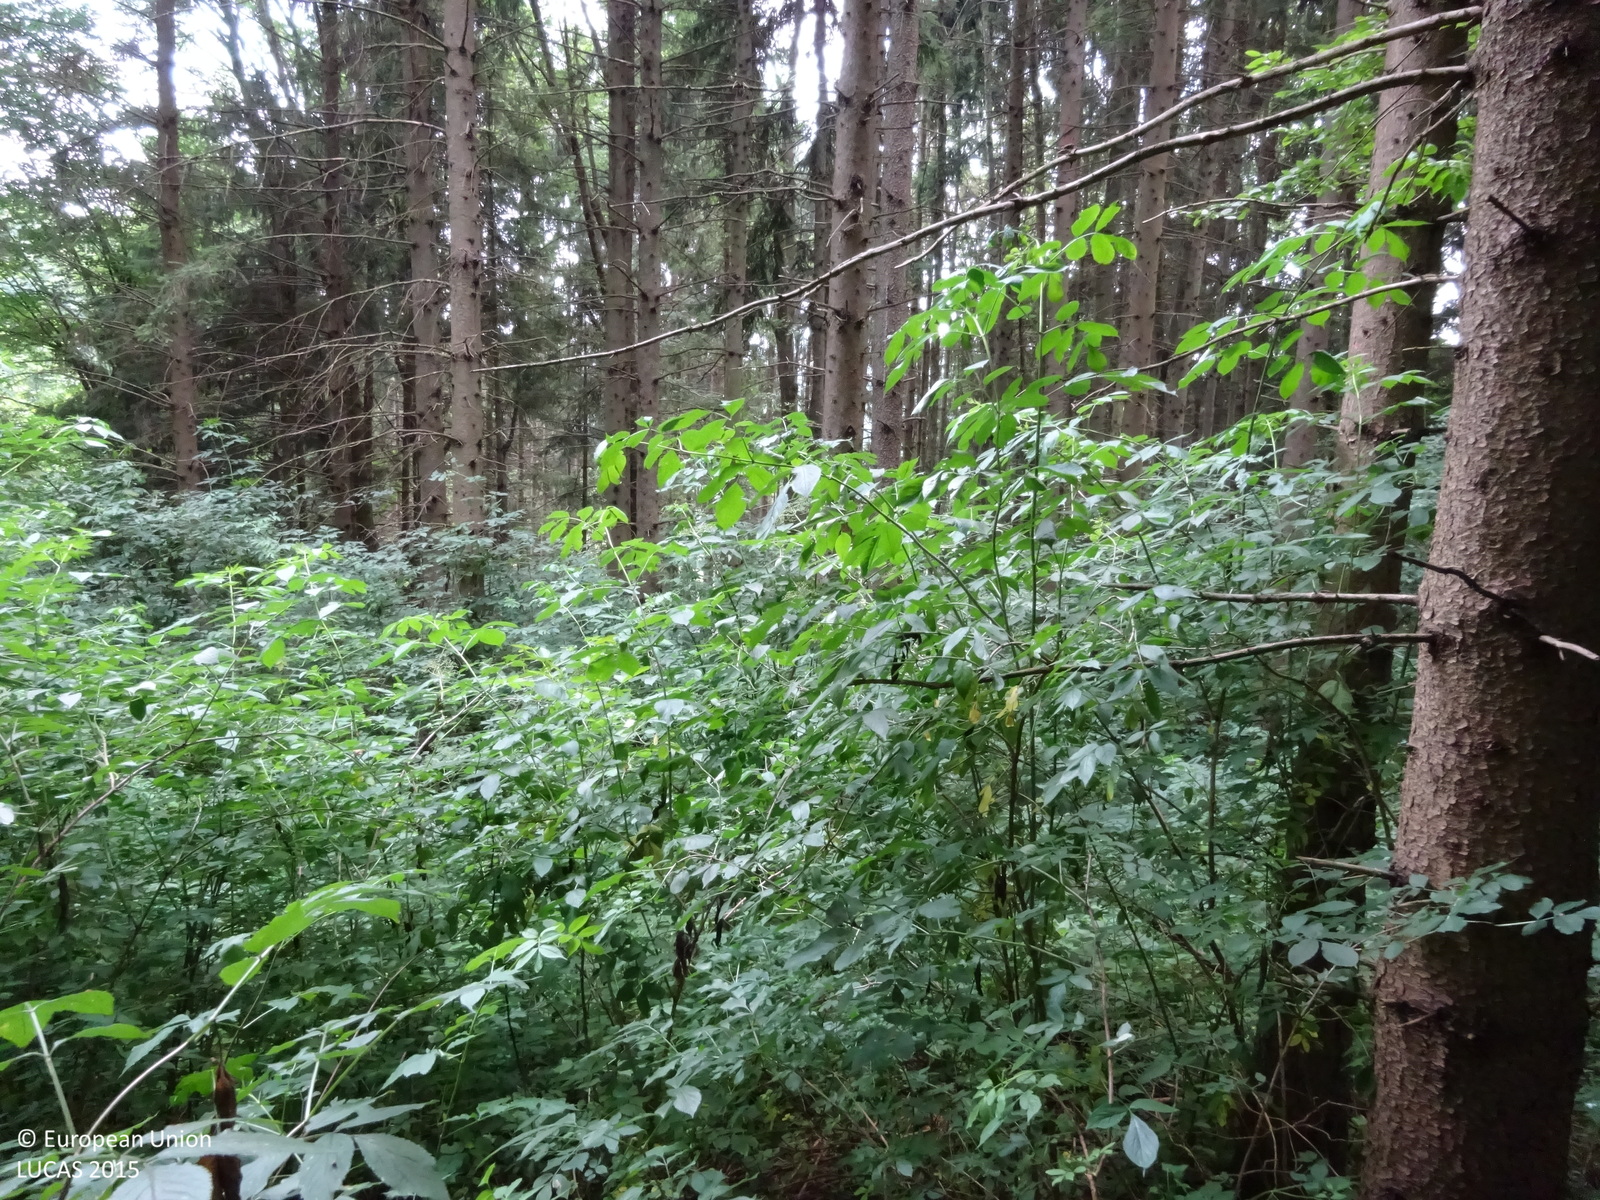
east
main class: Woodland
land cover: Spruce dominated mixed woodland
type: mountainous beech forest
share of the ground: > 75 %
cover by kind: broadleaved forest trees 65 %, coniferous forest trees 25 %, shrubs 10 %
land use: Forestry
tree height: > 5 m
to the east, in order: Spruce dominated mixed woodland; Spruce dominated coniferous woodland; Tracks; Spruce dominated coniferous woodland; Grassland without tree/shrub cover; Barley; Grassland without tree/shrub cover; Grass margins; Artificial constructions in urban areas; Broadleaved woodland; Artificial constructions in urban areas; Grassland without tree/shrub cover
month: July
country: AT
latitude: 46.9273
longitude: 15.9238
